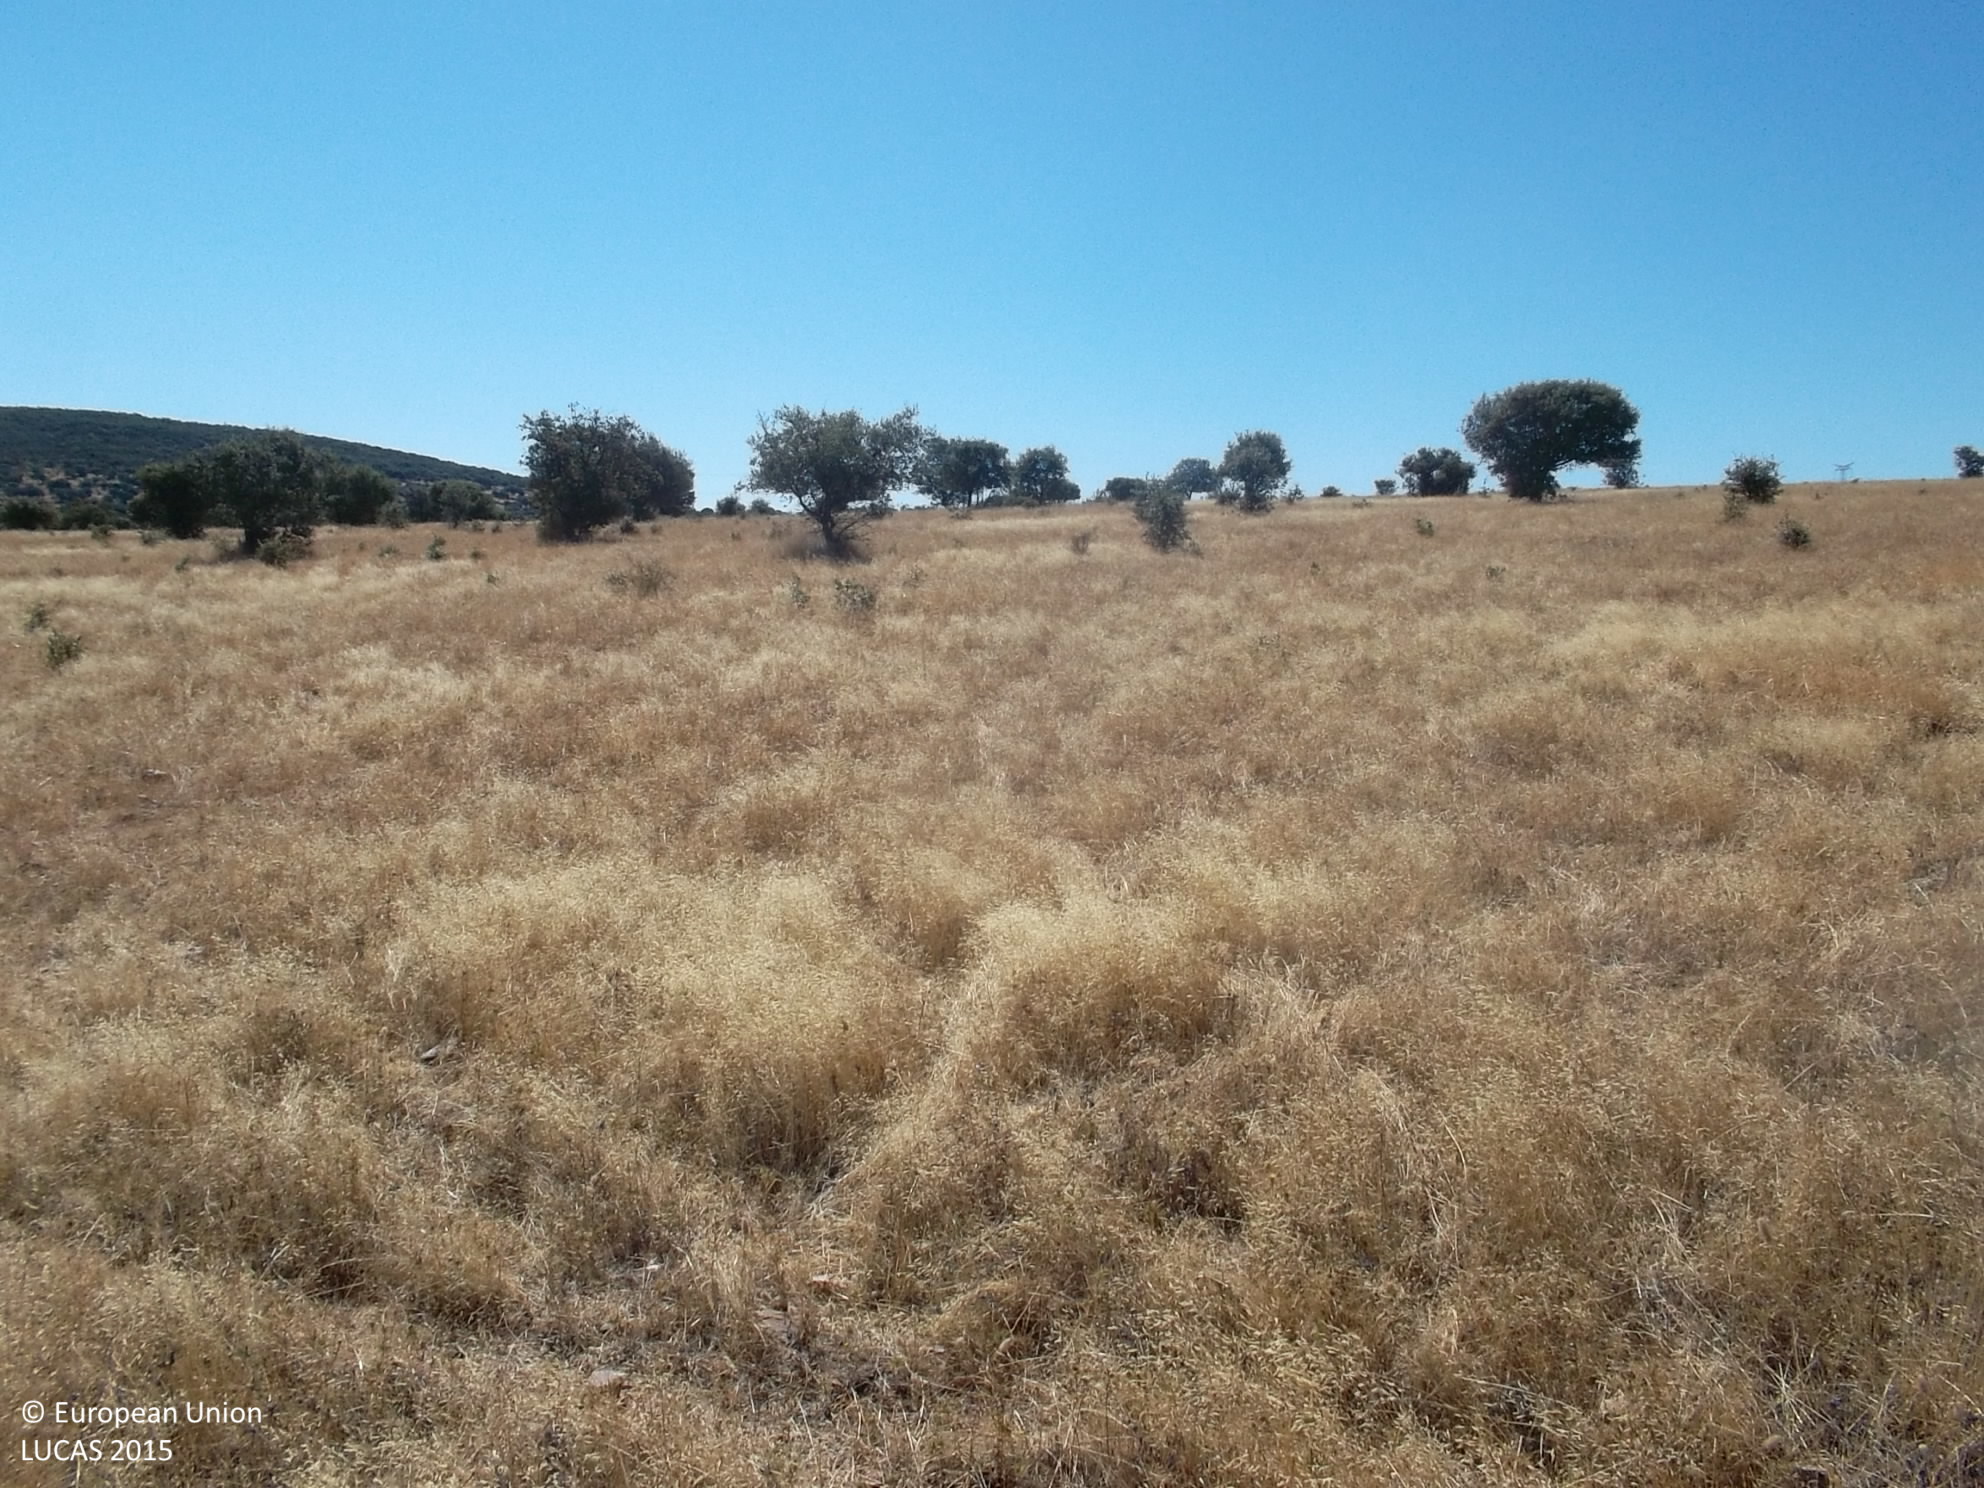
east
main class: Grassland
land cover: Grassland with sparse tree/shrub cover
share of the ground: > 75 %
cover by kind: herbaceous plants 90 %, broadleaved forest trees 5 %, shrubs 5 %
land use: Agriculture (excluding fallow land and kitchen gardens)
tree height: < 5 m
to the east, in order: Grassland with sparse tree/shrub cover; Rivers and streams; Broadleaved woodland
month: July
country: ES
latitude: 38.4555
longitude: -5.8428
